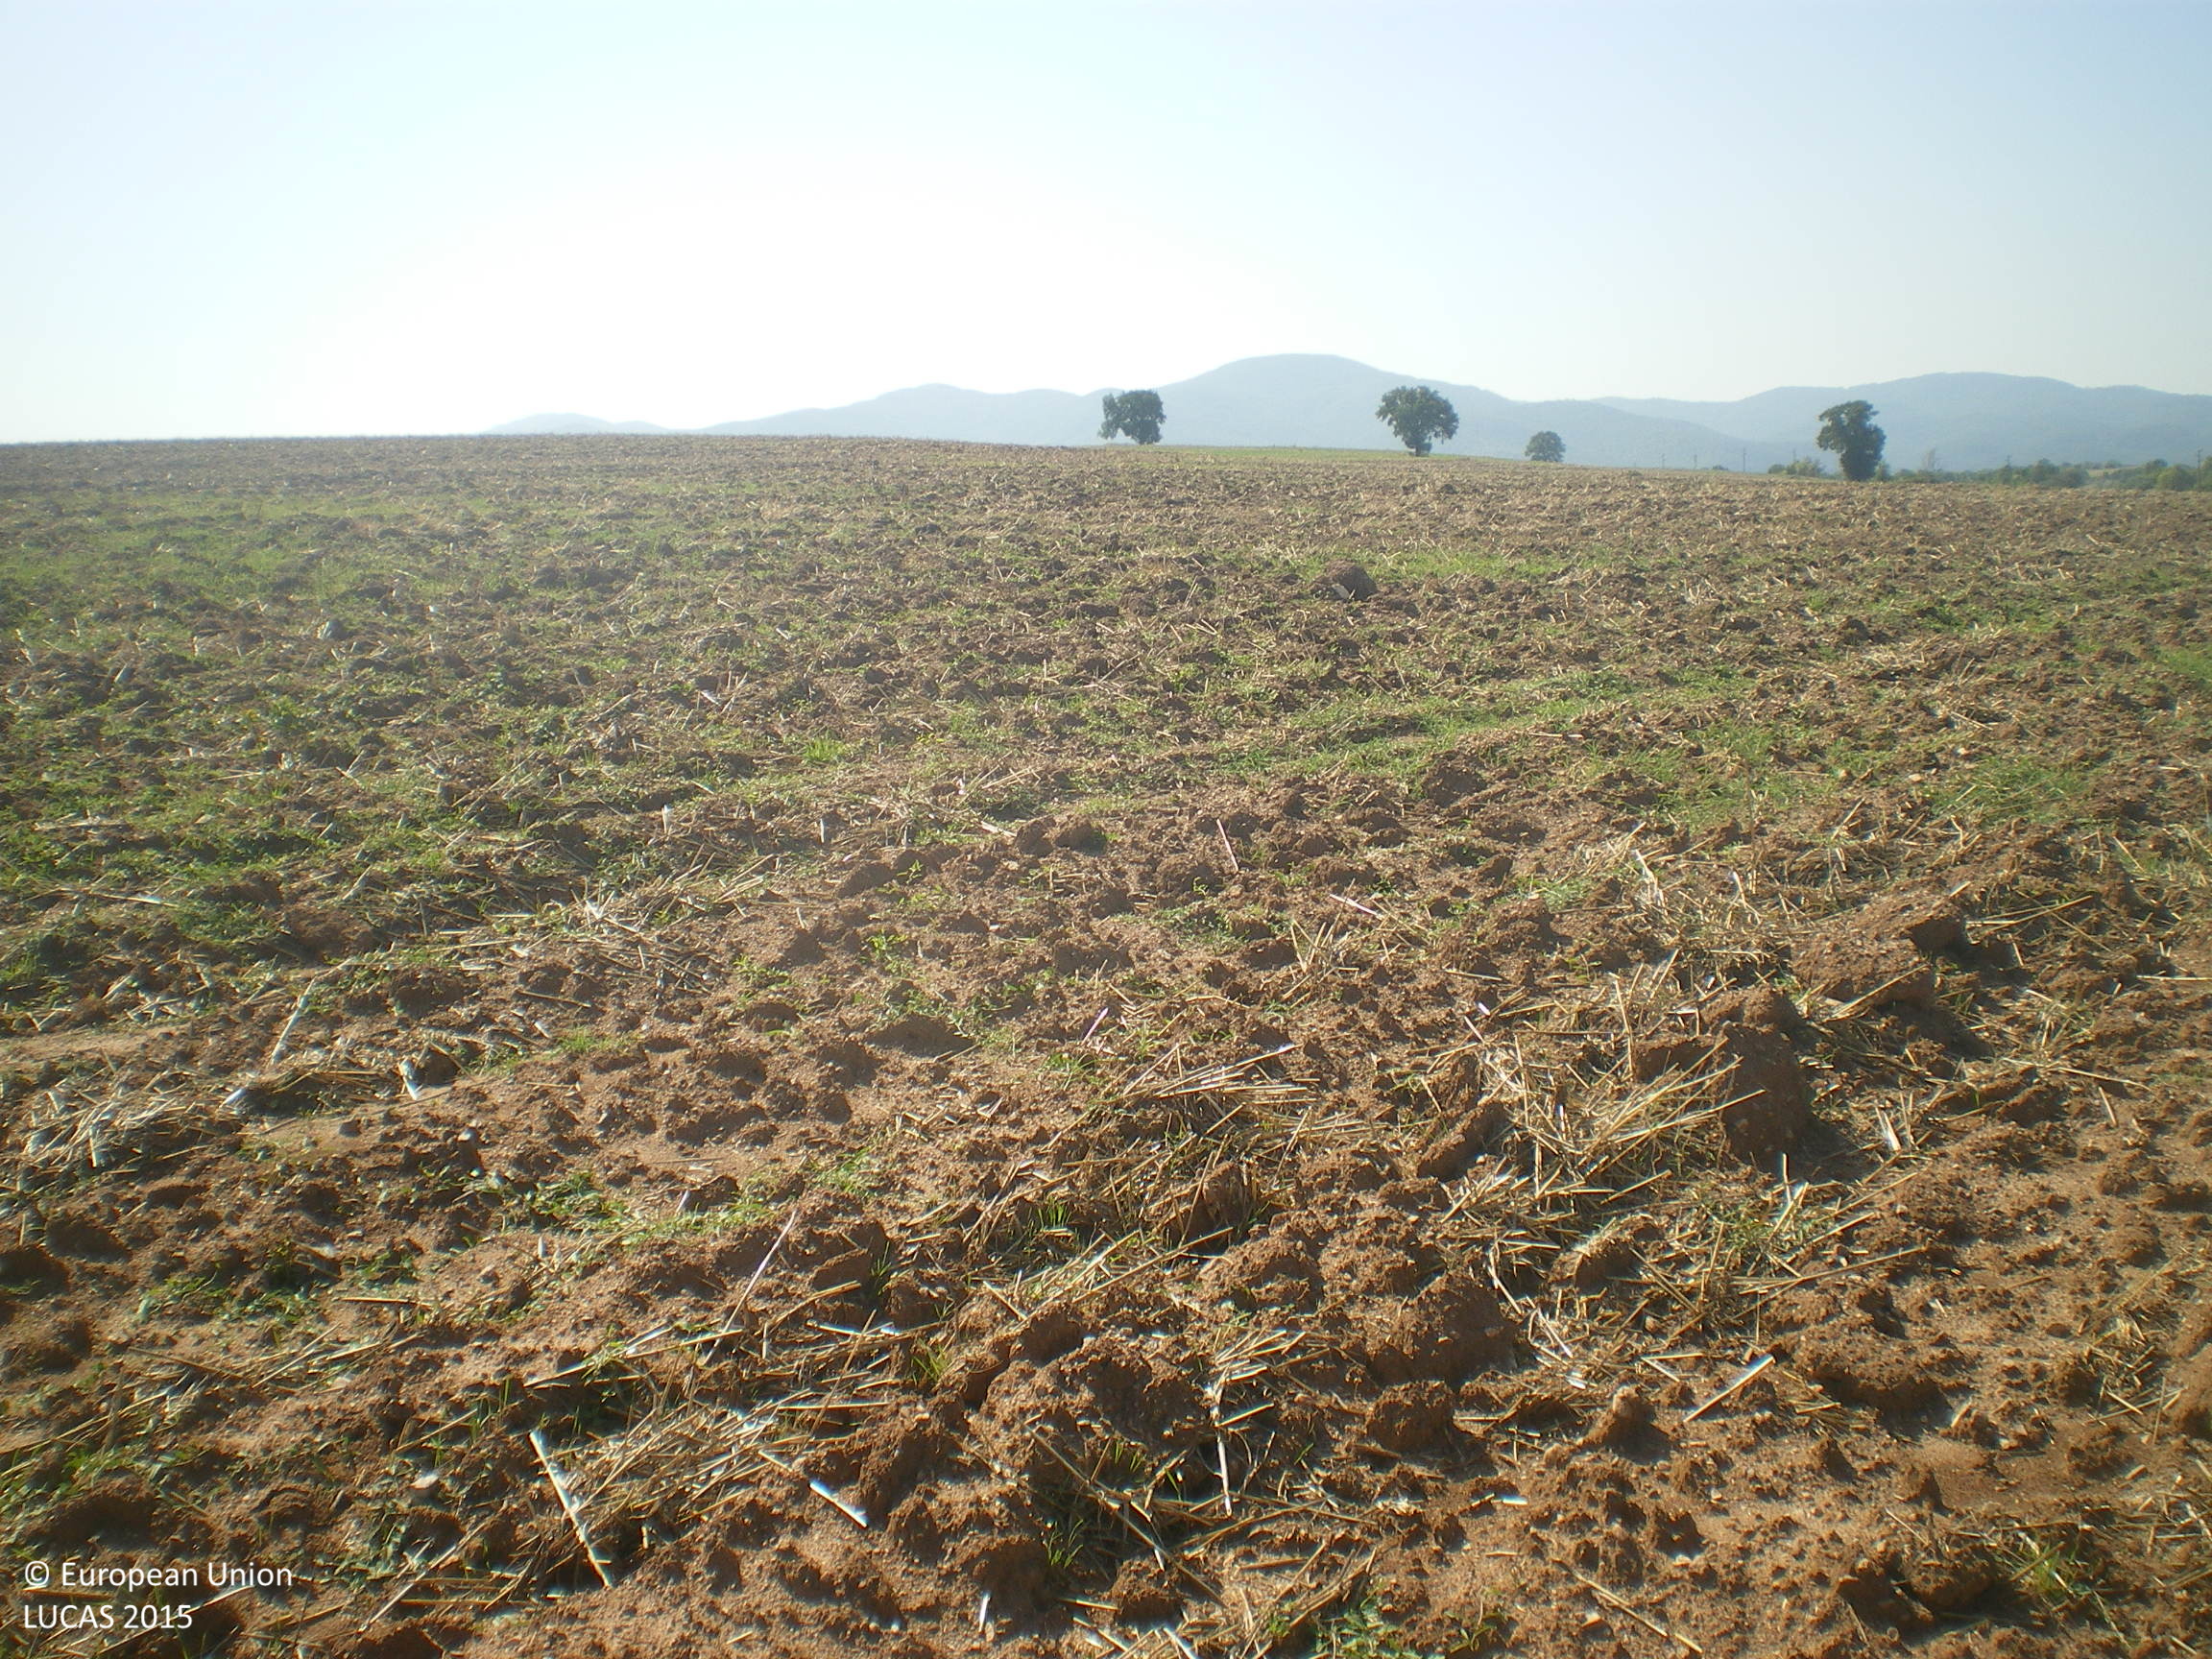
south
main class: Cropland
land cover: Common wheat
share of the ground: < 10 %
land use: Agriculture (excluding fallow land and kitchen gardens)
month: September
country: BG
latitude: 41.7924
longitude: 26.0168
